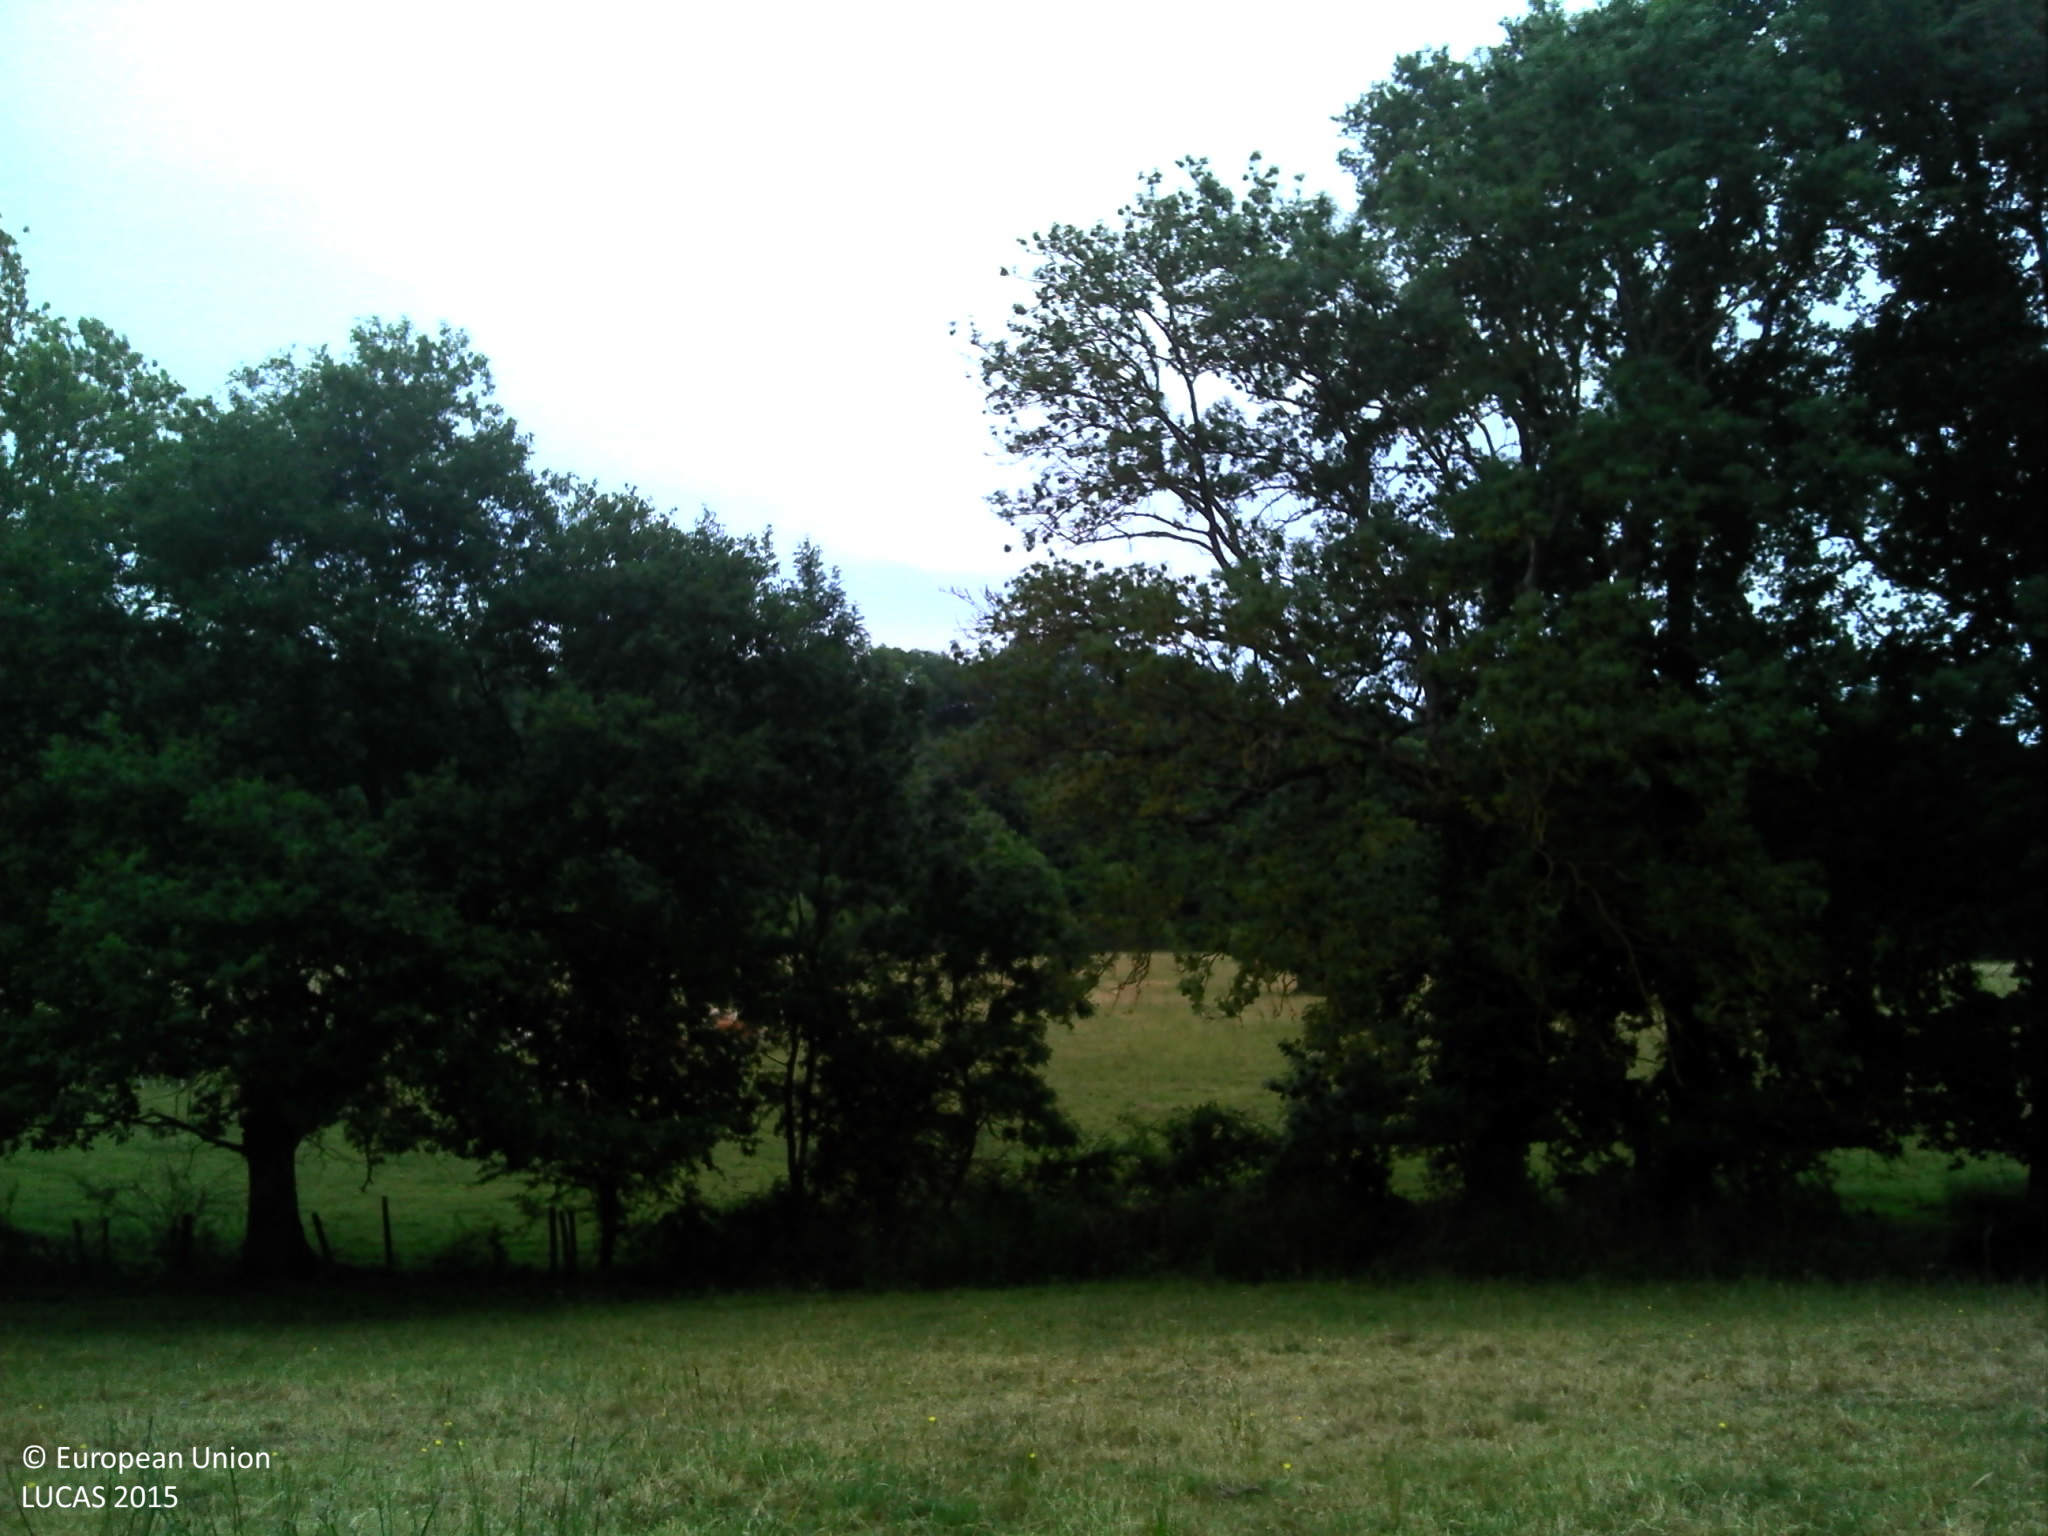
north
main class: Grassland
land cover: Grassland without tree/shrub cover
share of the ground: > 75 %
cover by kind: herbaceous plants 100 %
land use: Agriculture (excluding fallow land and kitchen gardens)
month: June
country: FR
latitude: 48.3073
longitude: -0.0471
